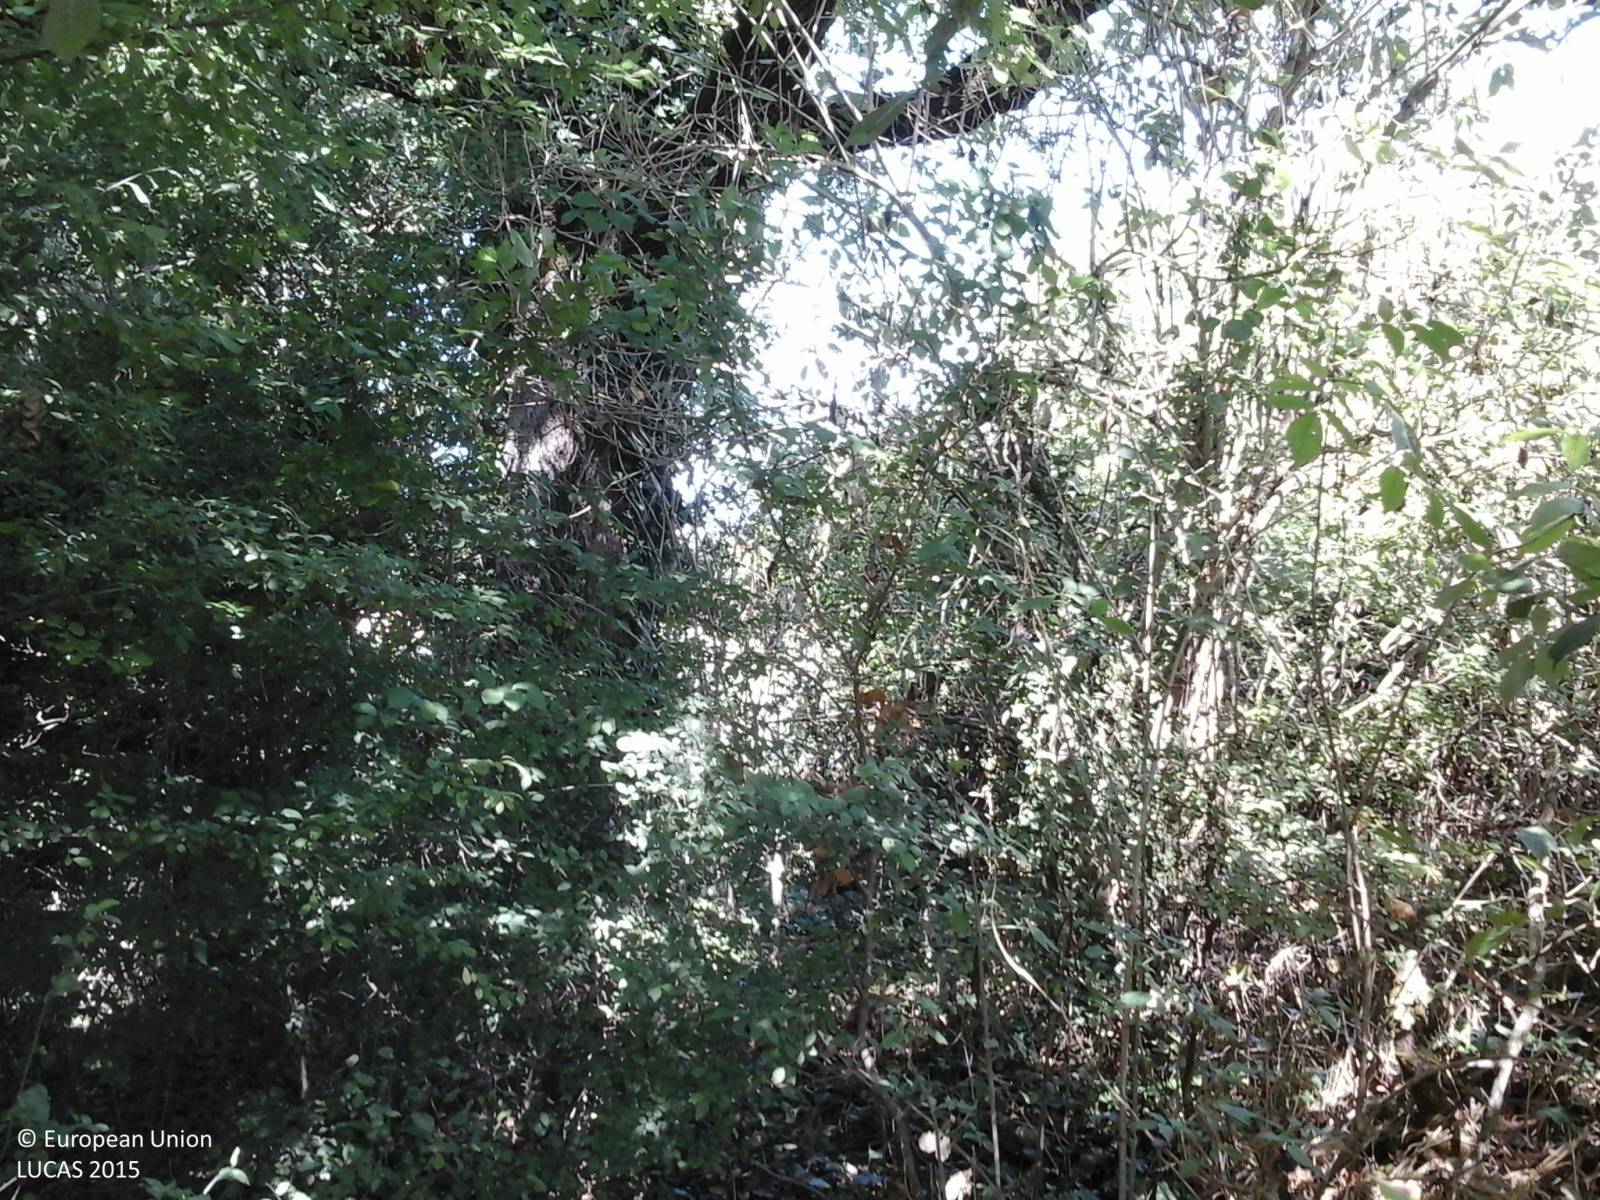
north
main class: Woodland
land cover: Broadleaved woodland
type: thermophilous deciduous forest
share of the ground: > 75 %
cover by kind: broadleaved forest trees 90 %, shrubs 10 %
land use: Abandoned areas
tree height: > 5 m
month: September
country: IT
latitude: 42.3135
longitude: 12.5996
